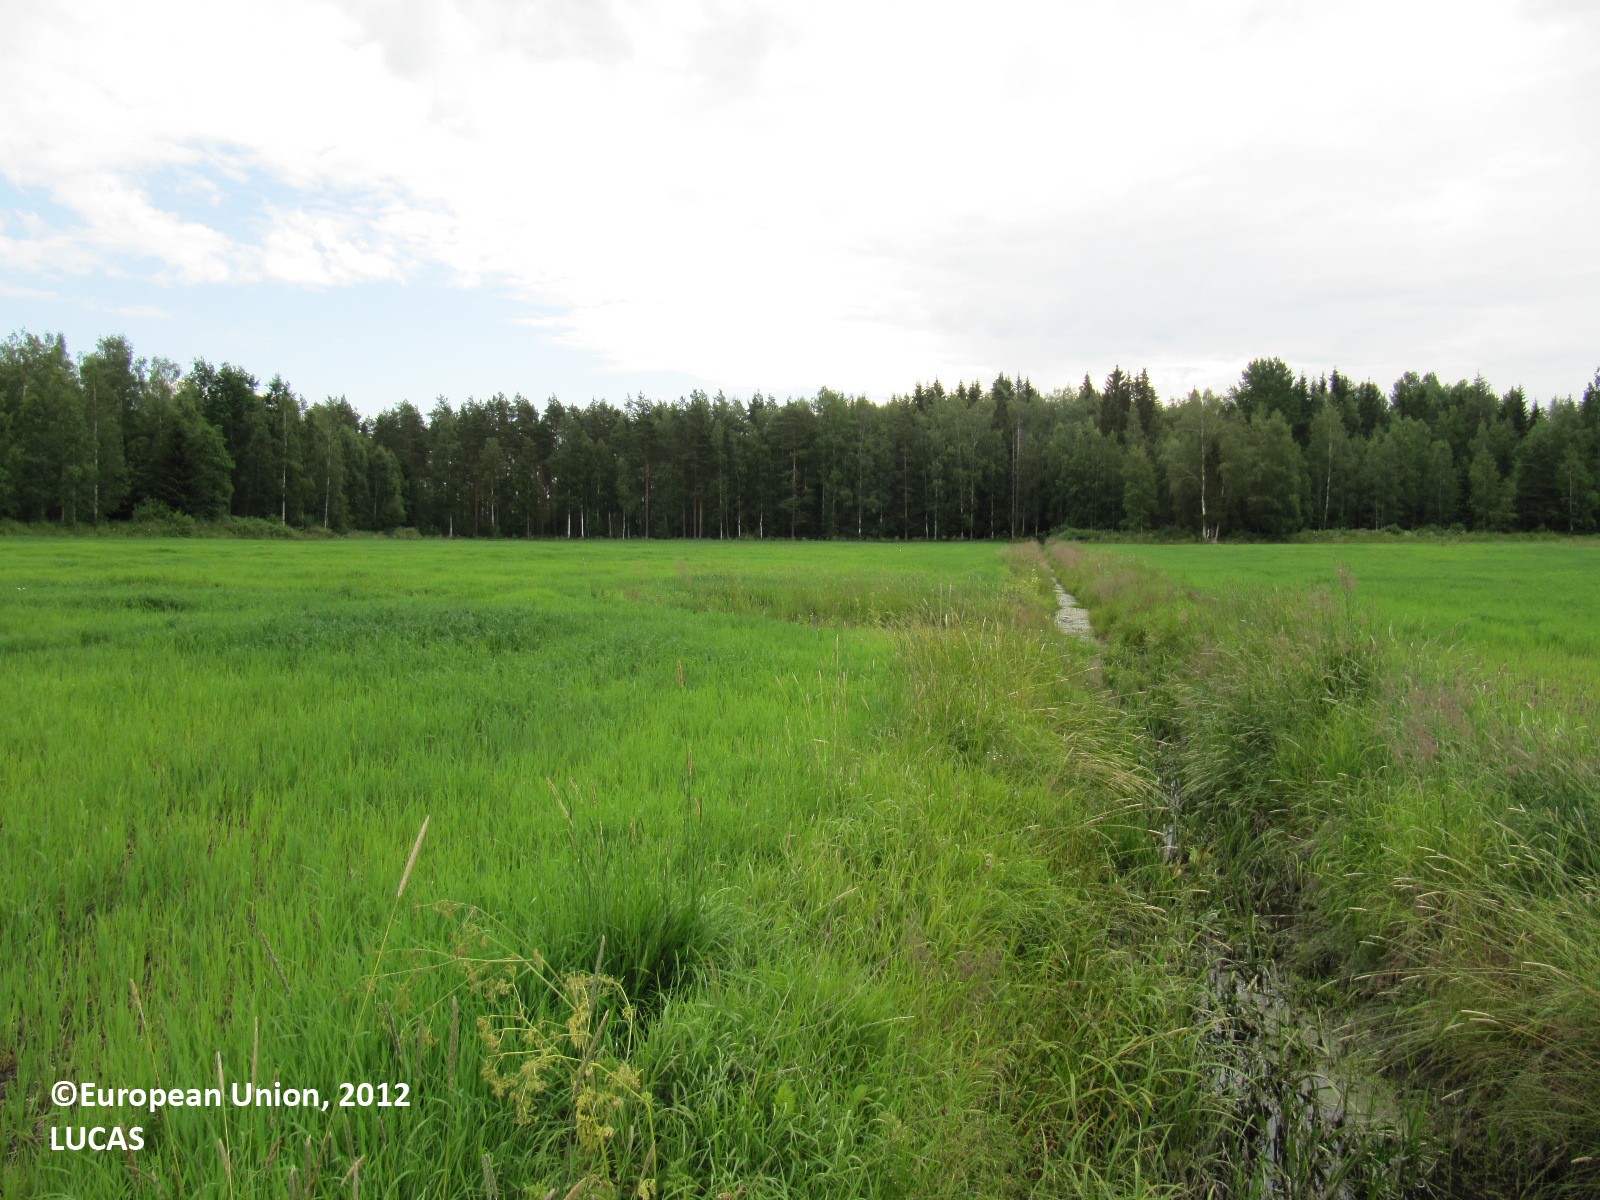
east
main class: Cropland
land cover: Oats
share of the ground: 50 - 75 %
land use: Agriculture (excluding fallow land and kitchen gardens)
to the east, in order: Artificial constructions; Ditches and canals; Oats; Ditches and canals; Spruce dominated mixed woodland
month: July
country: FI
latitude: 60.9057
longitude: 23.4492
